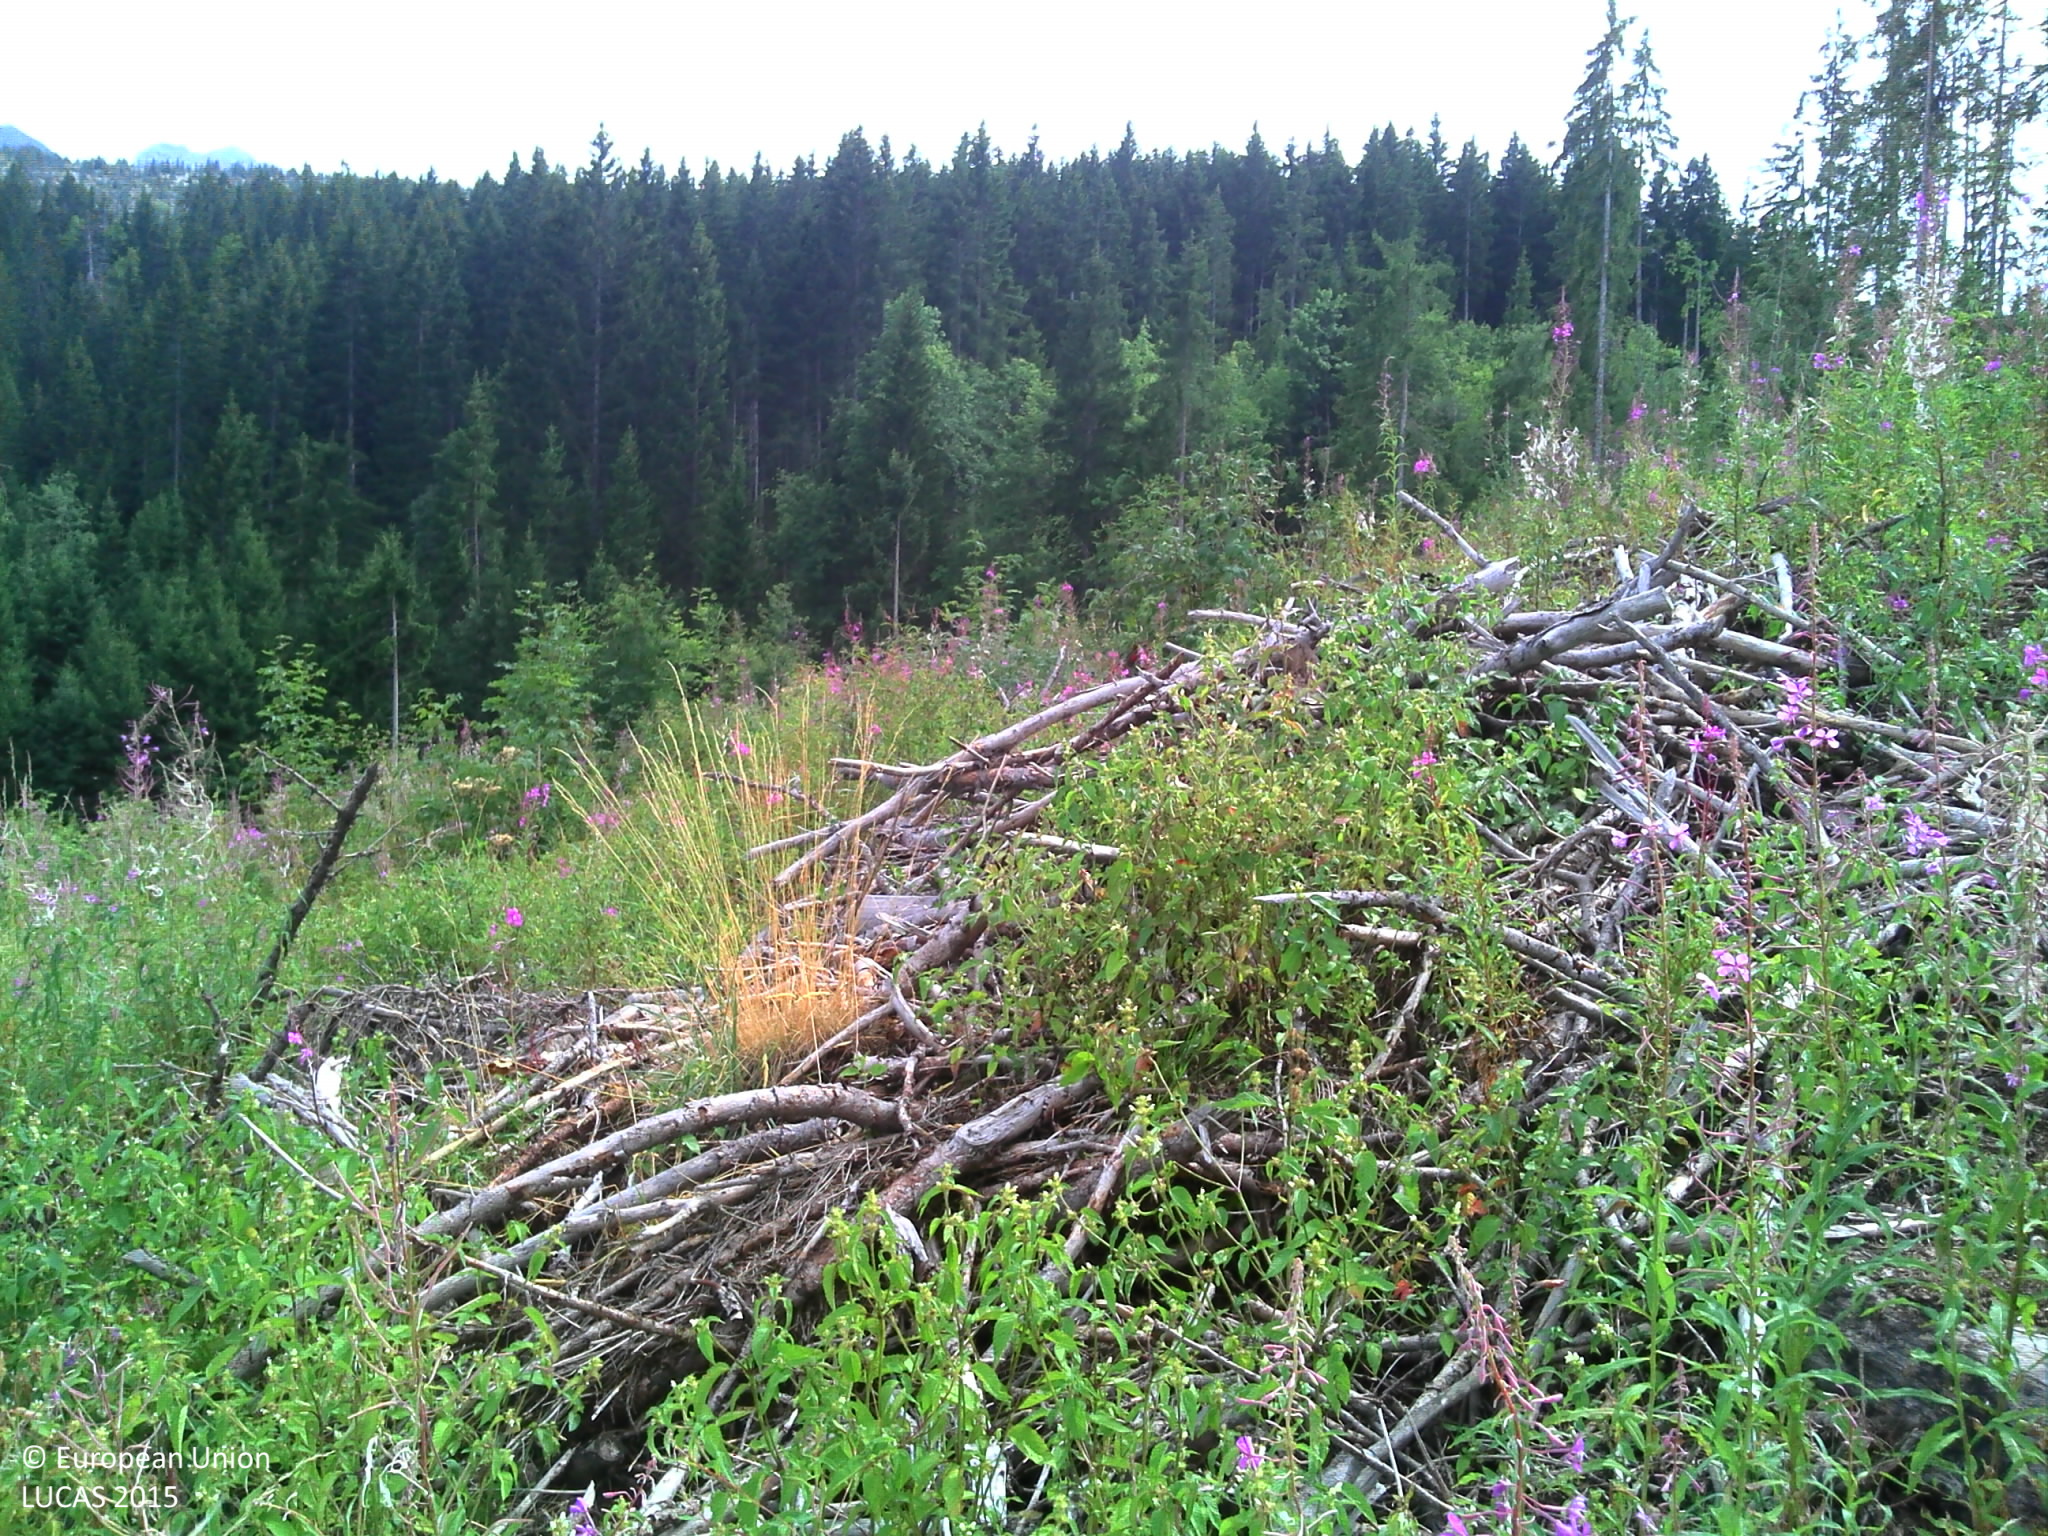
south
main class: Grassland
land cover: Spontaneously vegetated surfaces
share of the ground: > 75 %
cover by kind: herbaceous plants 100 %
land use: Semi-natural and natural areas not in use
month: July
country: FR
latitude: 46.0399
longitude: 6.4502
